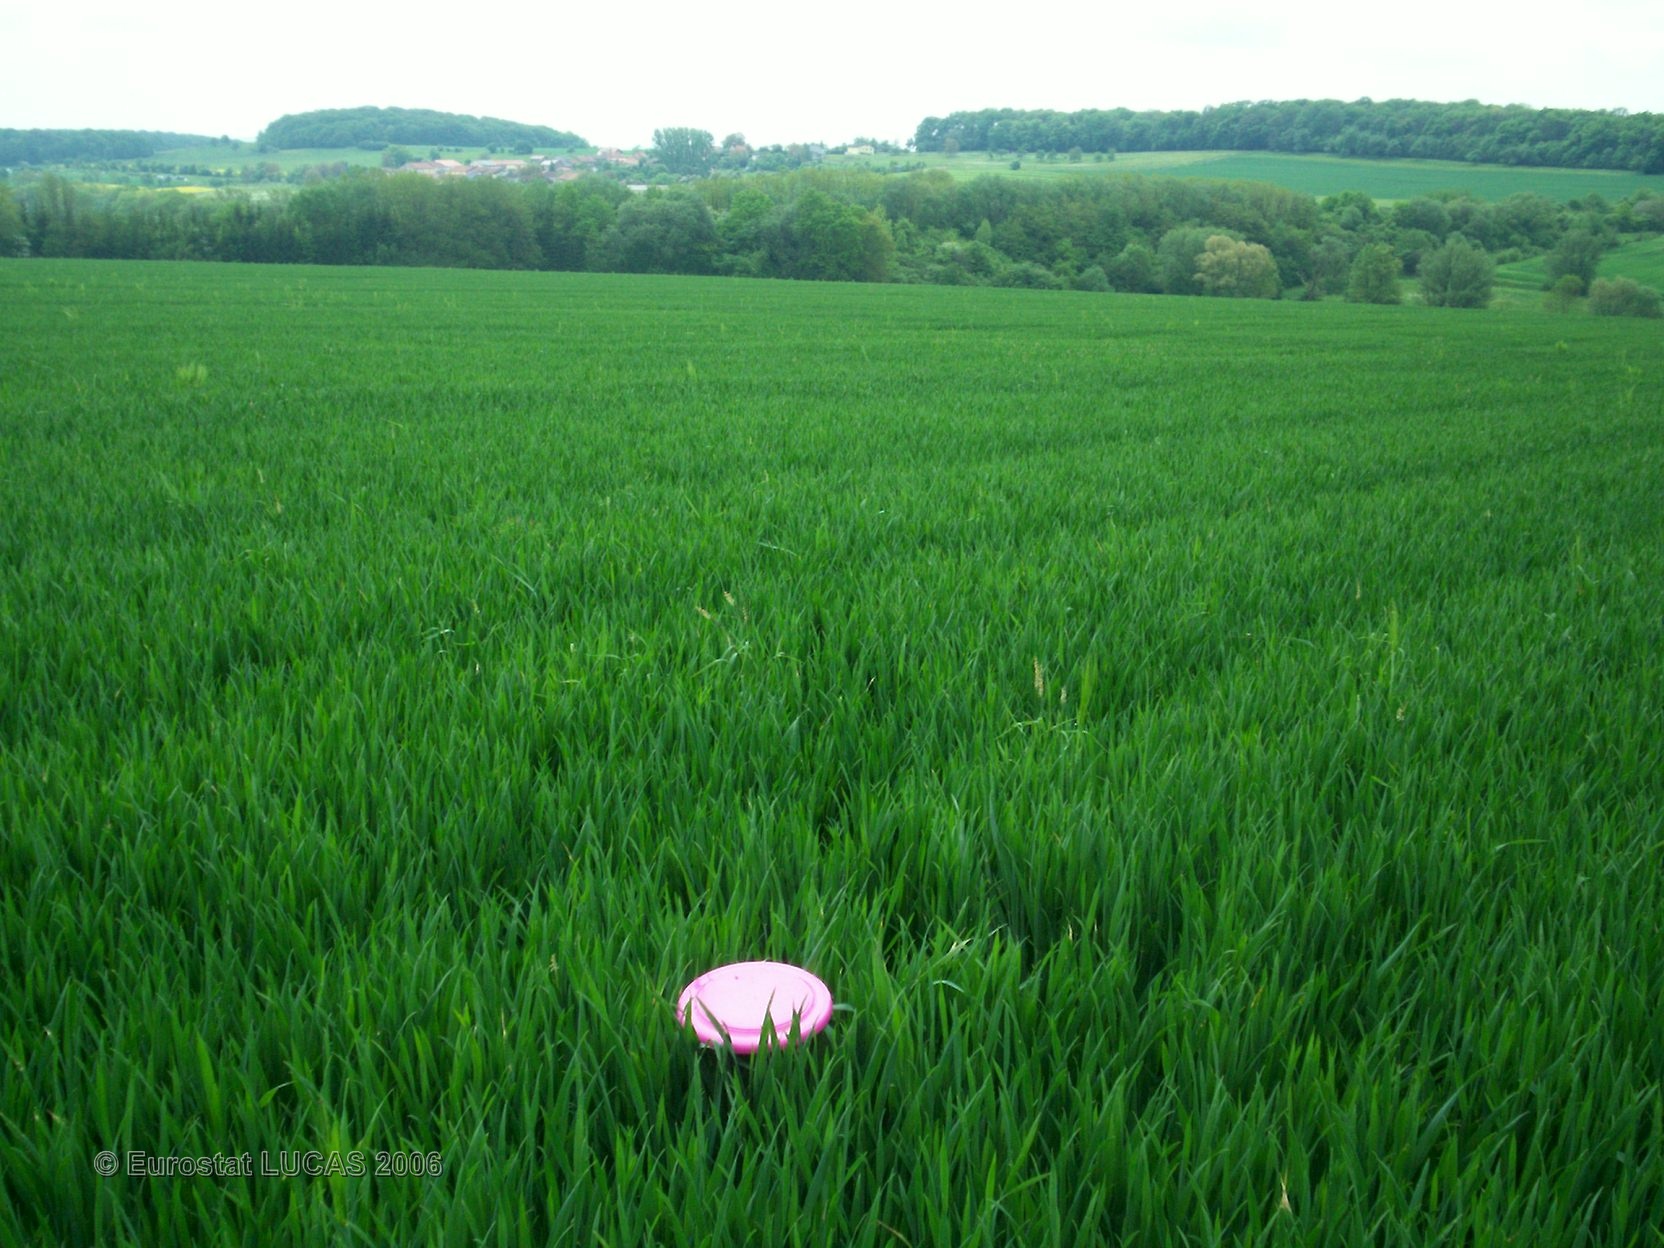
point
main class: Cropland
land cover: Common wheat
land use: Agriculture (excluding fallow land and kitchen gardens)
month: May
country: FR
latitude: 49.3929
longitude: 6.5141
